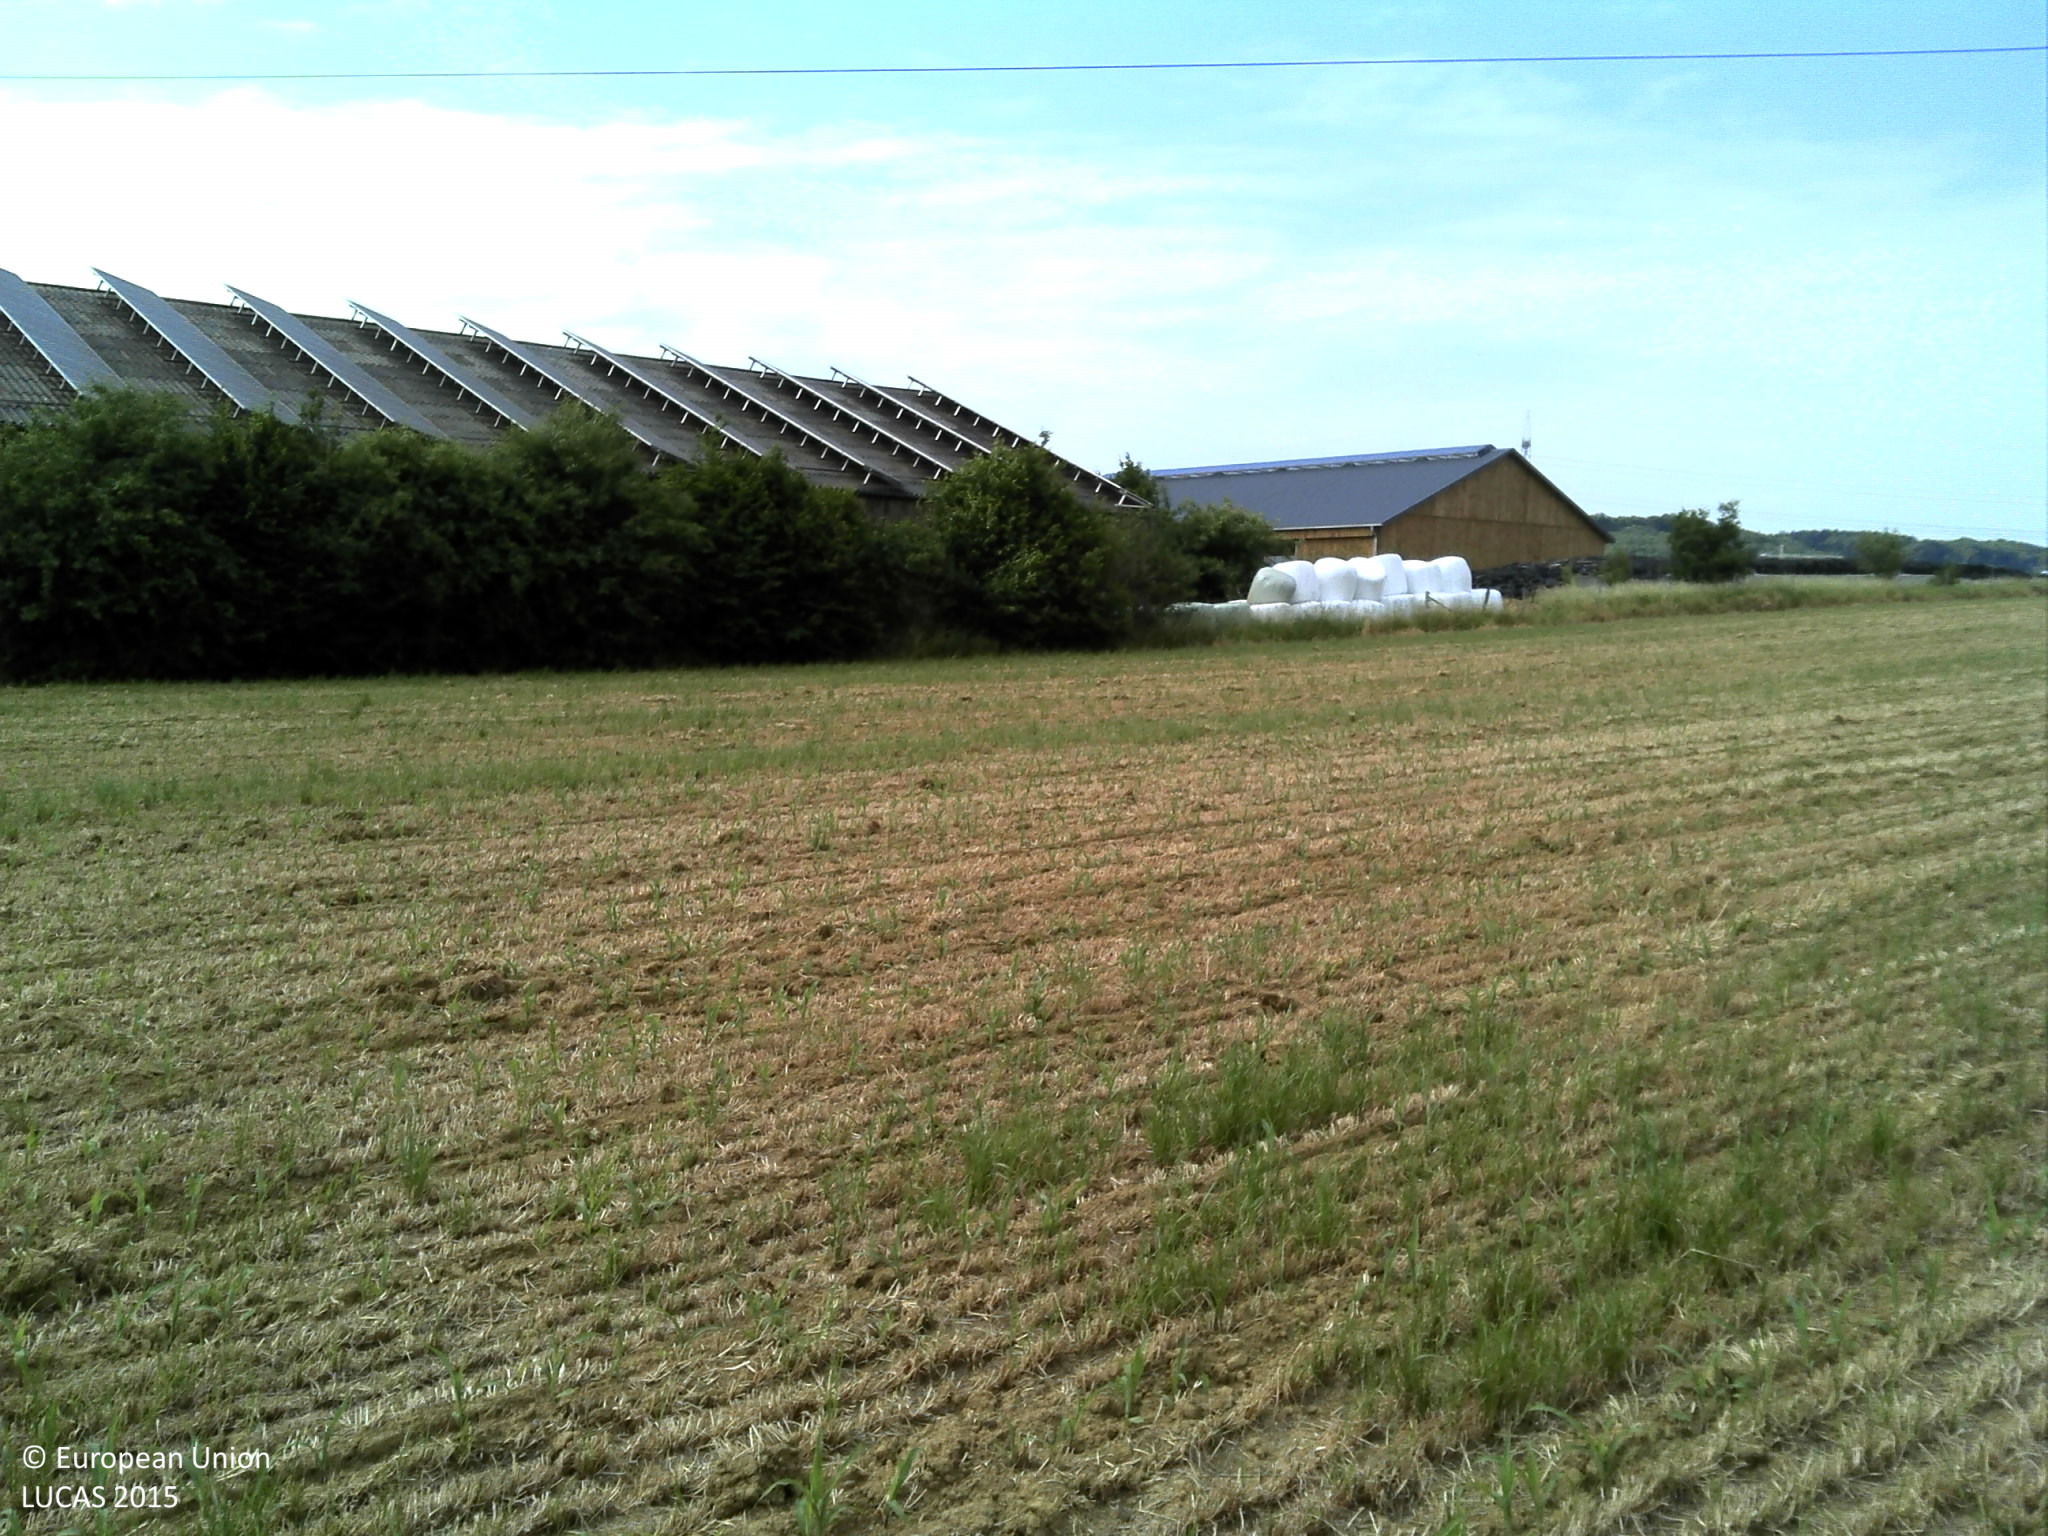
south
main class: Cropland
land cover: Maize
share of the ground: < 10 %
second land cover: Temporary grasslands
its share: 25 - 50 %
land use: Agriculture (excluding fallow land and kitchen gardens)
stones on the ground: < 10 %
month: June
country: LU
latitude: 49.5211
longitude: 6.0347
